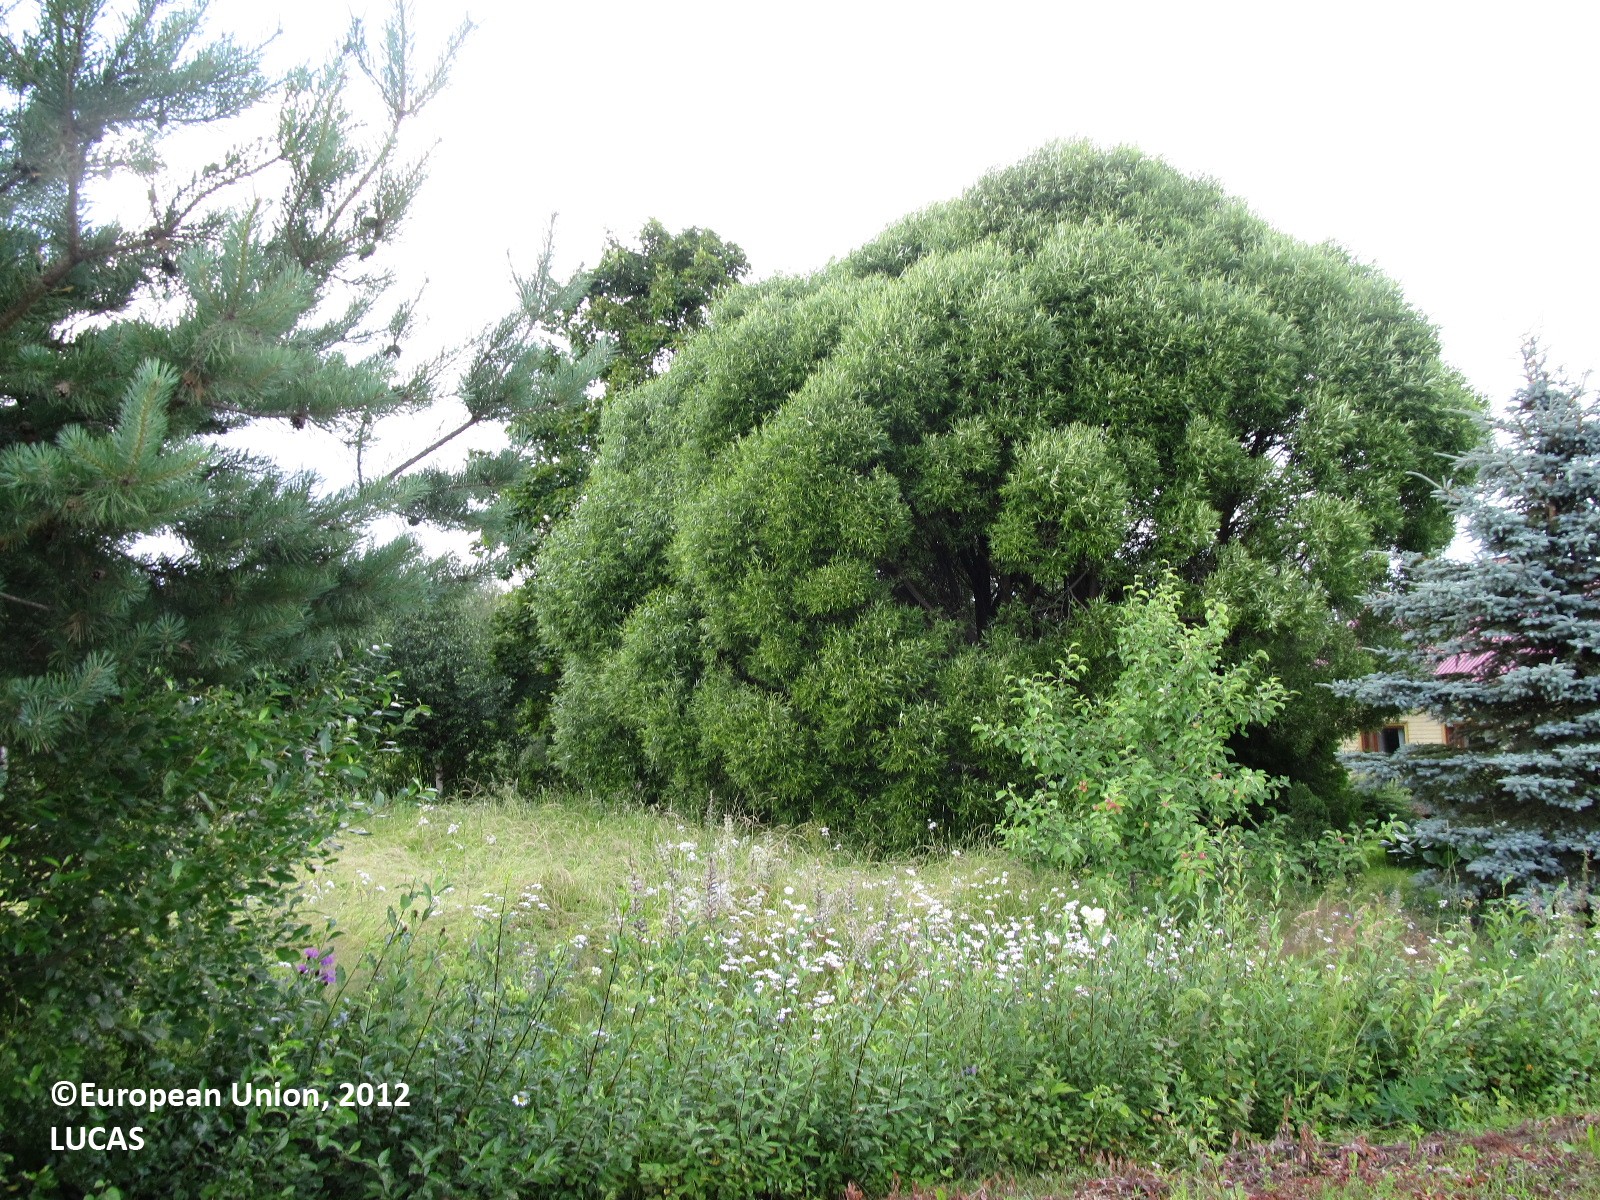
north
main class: Cropland
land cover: Common wheat
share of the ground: > 75 %
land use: Agriculture (excluding fallow land and kitchen gardens)
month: July
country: FI
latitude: 62.0257
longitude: 28.0586
